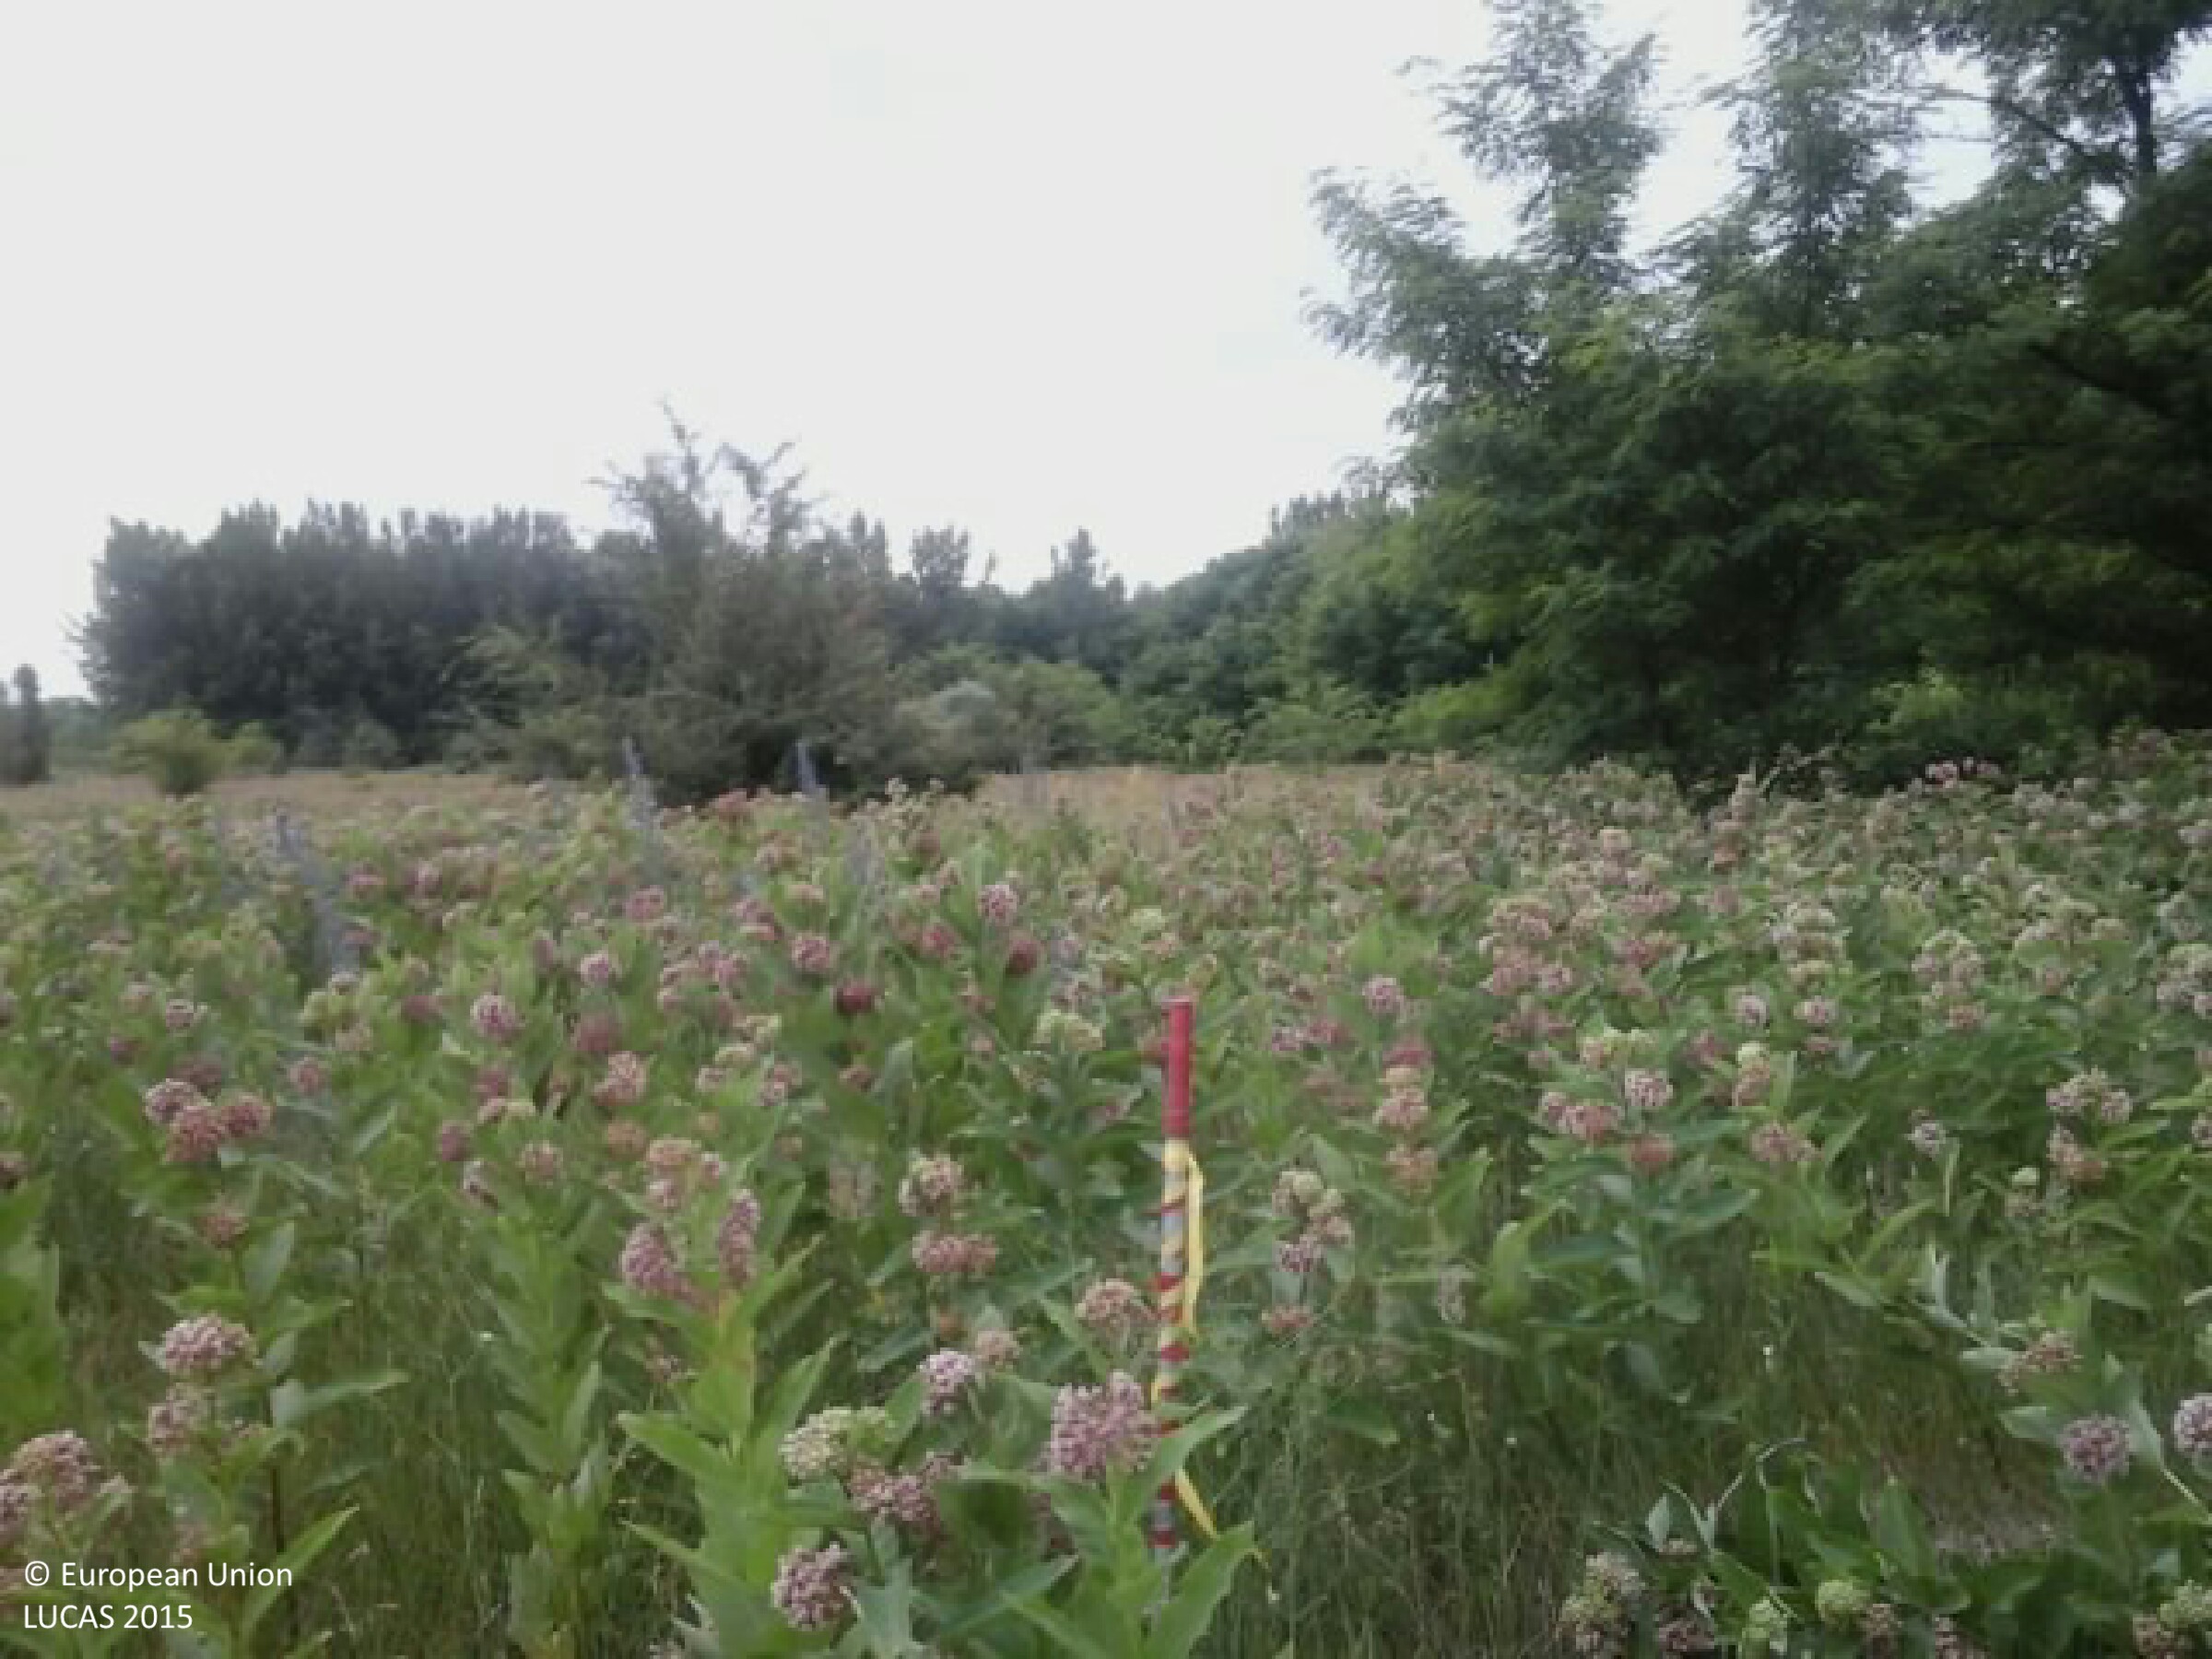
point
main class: Grassland
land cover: Grassland with sparse tree/shrub cover
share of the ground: > 75 %
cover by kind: herbaceous plants 95 %, broadleaved forest trees 5 %
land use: Agriculture (excluding fallow land and kitchen gardens)
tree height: > 5 m
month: June
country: HU
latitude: 46.7620
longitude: 19.6960
